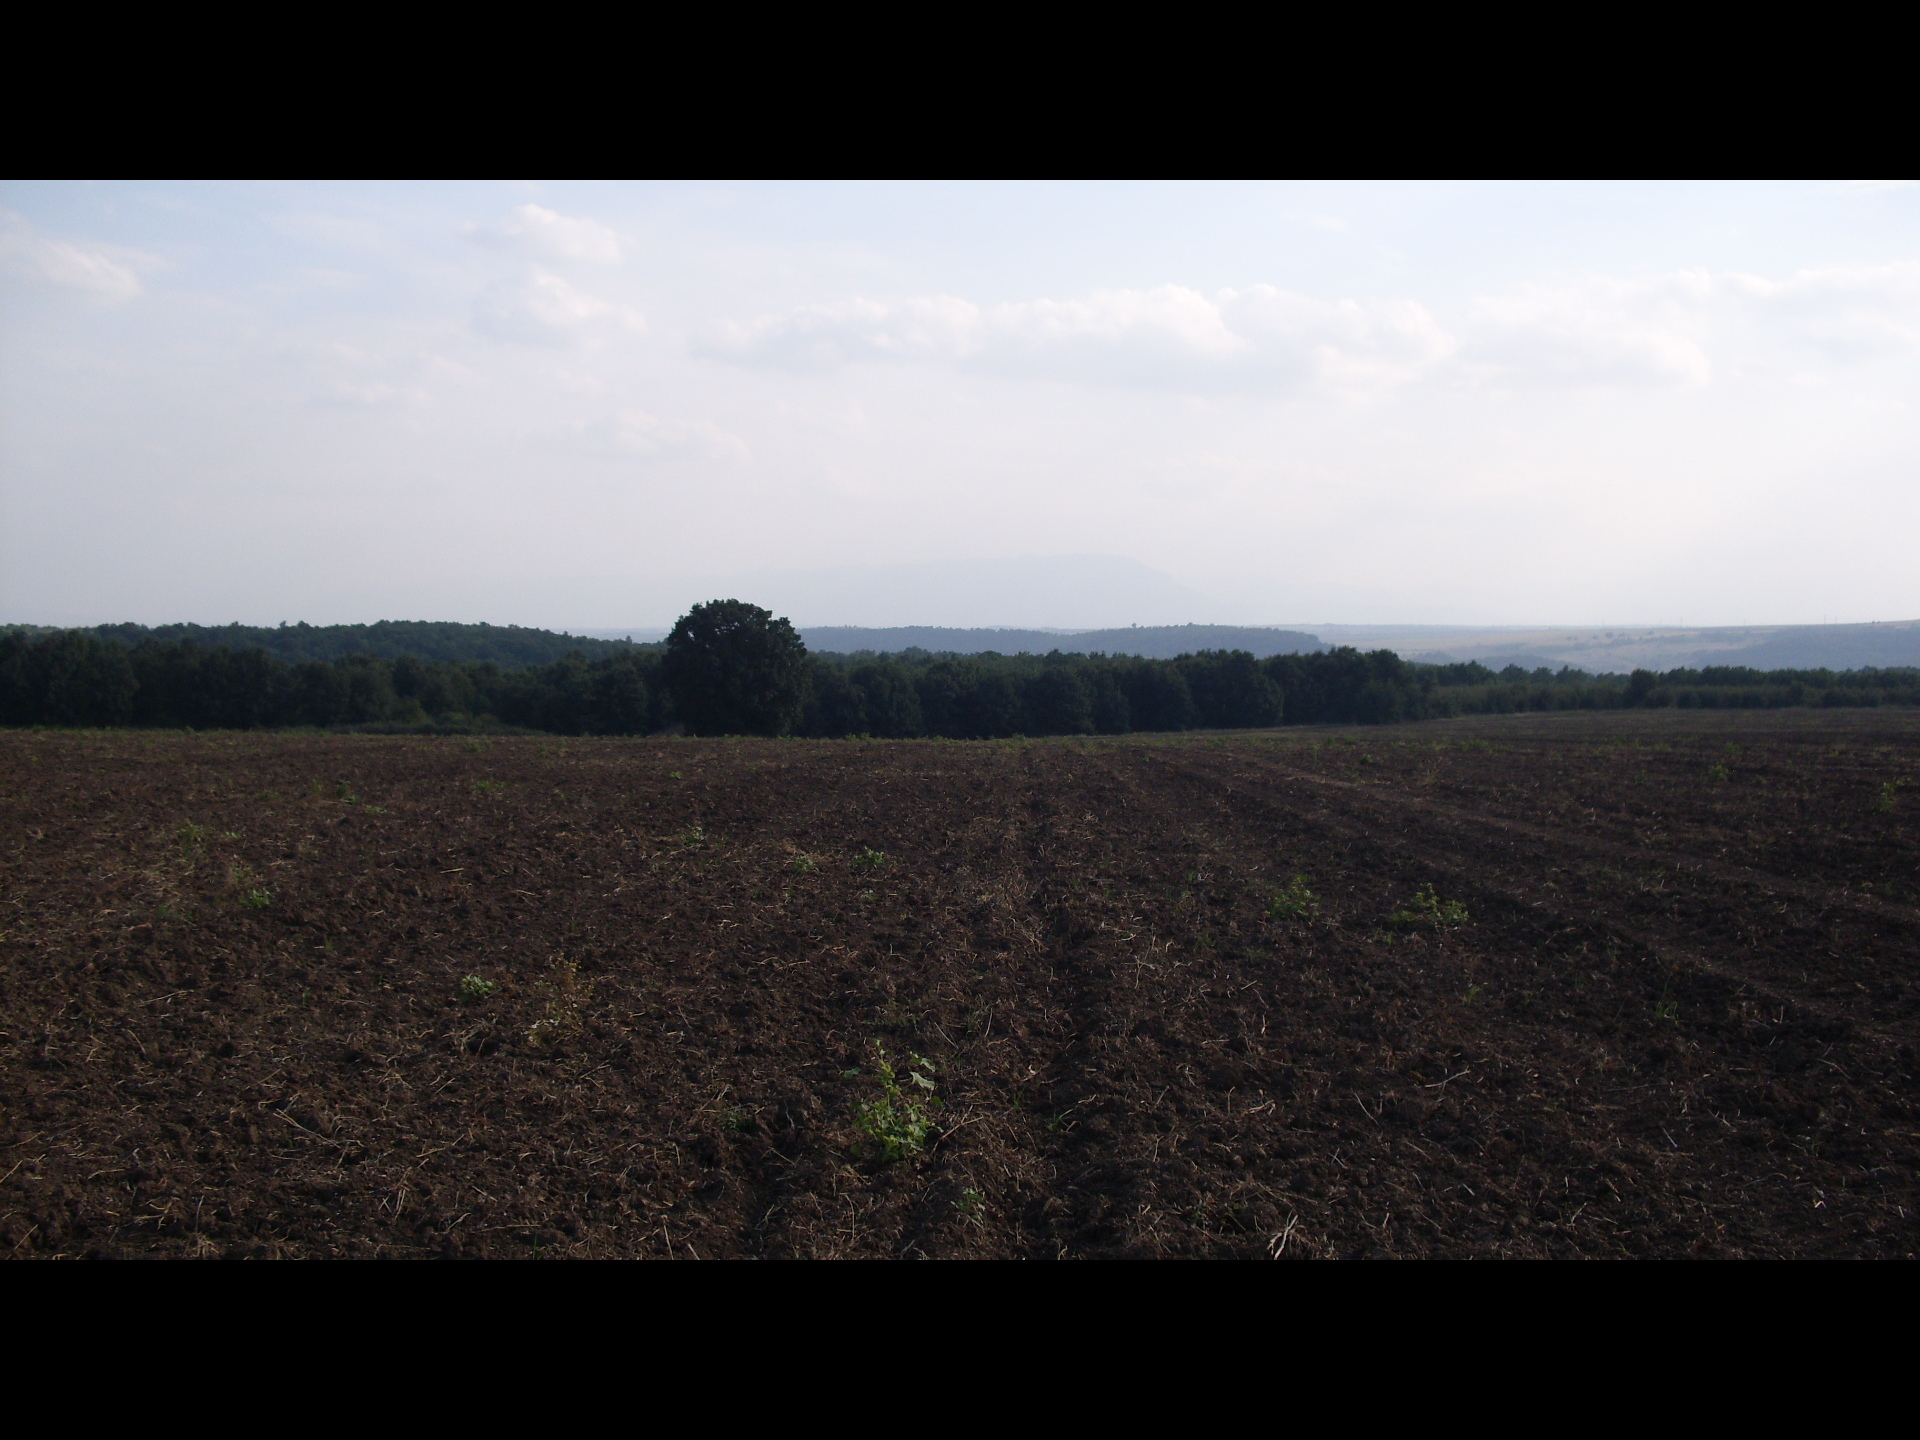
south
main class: Cropland
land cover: Rape and turnip rape
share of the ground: < 10 %
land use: Agriculture (excluding fallow land and kitchen gardens)
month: September
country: BG
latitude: 43.4583
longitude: 23.4028
